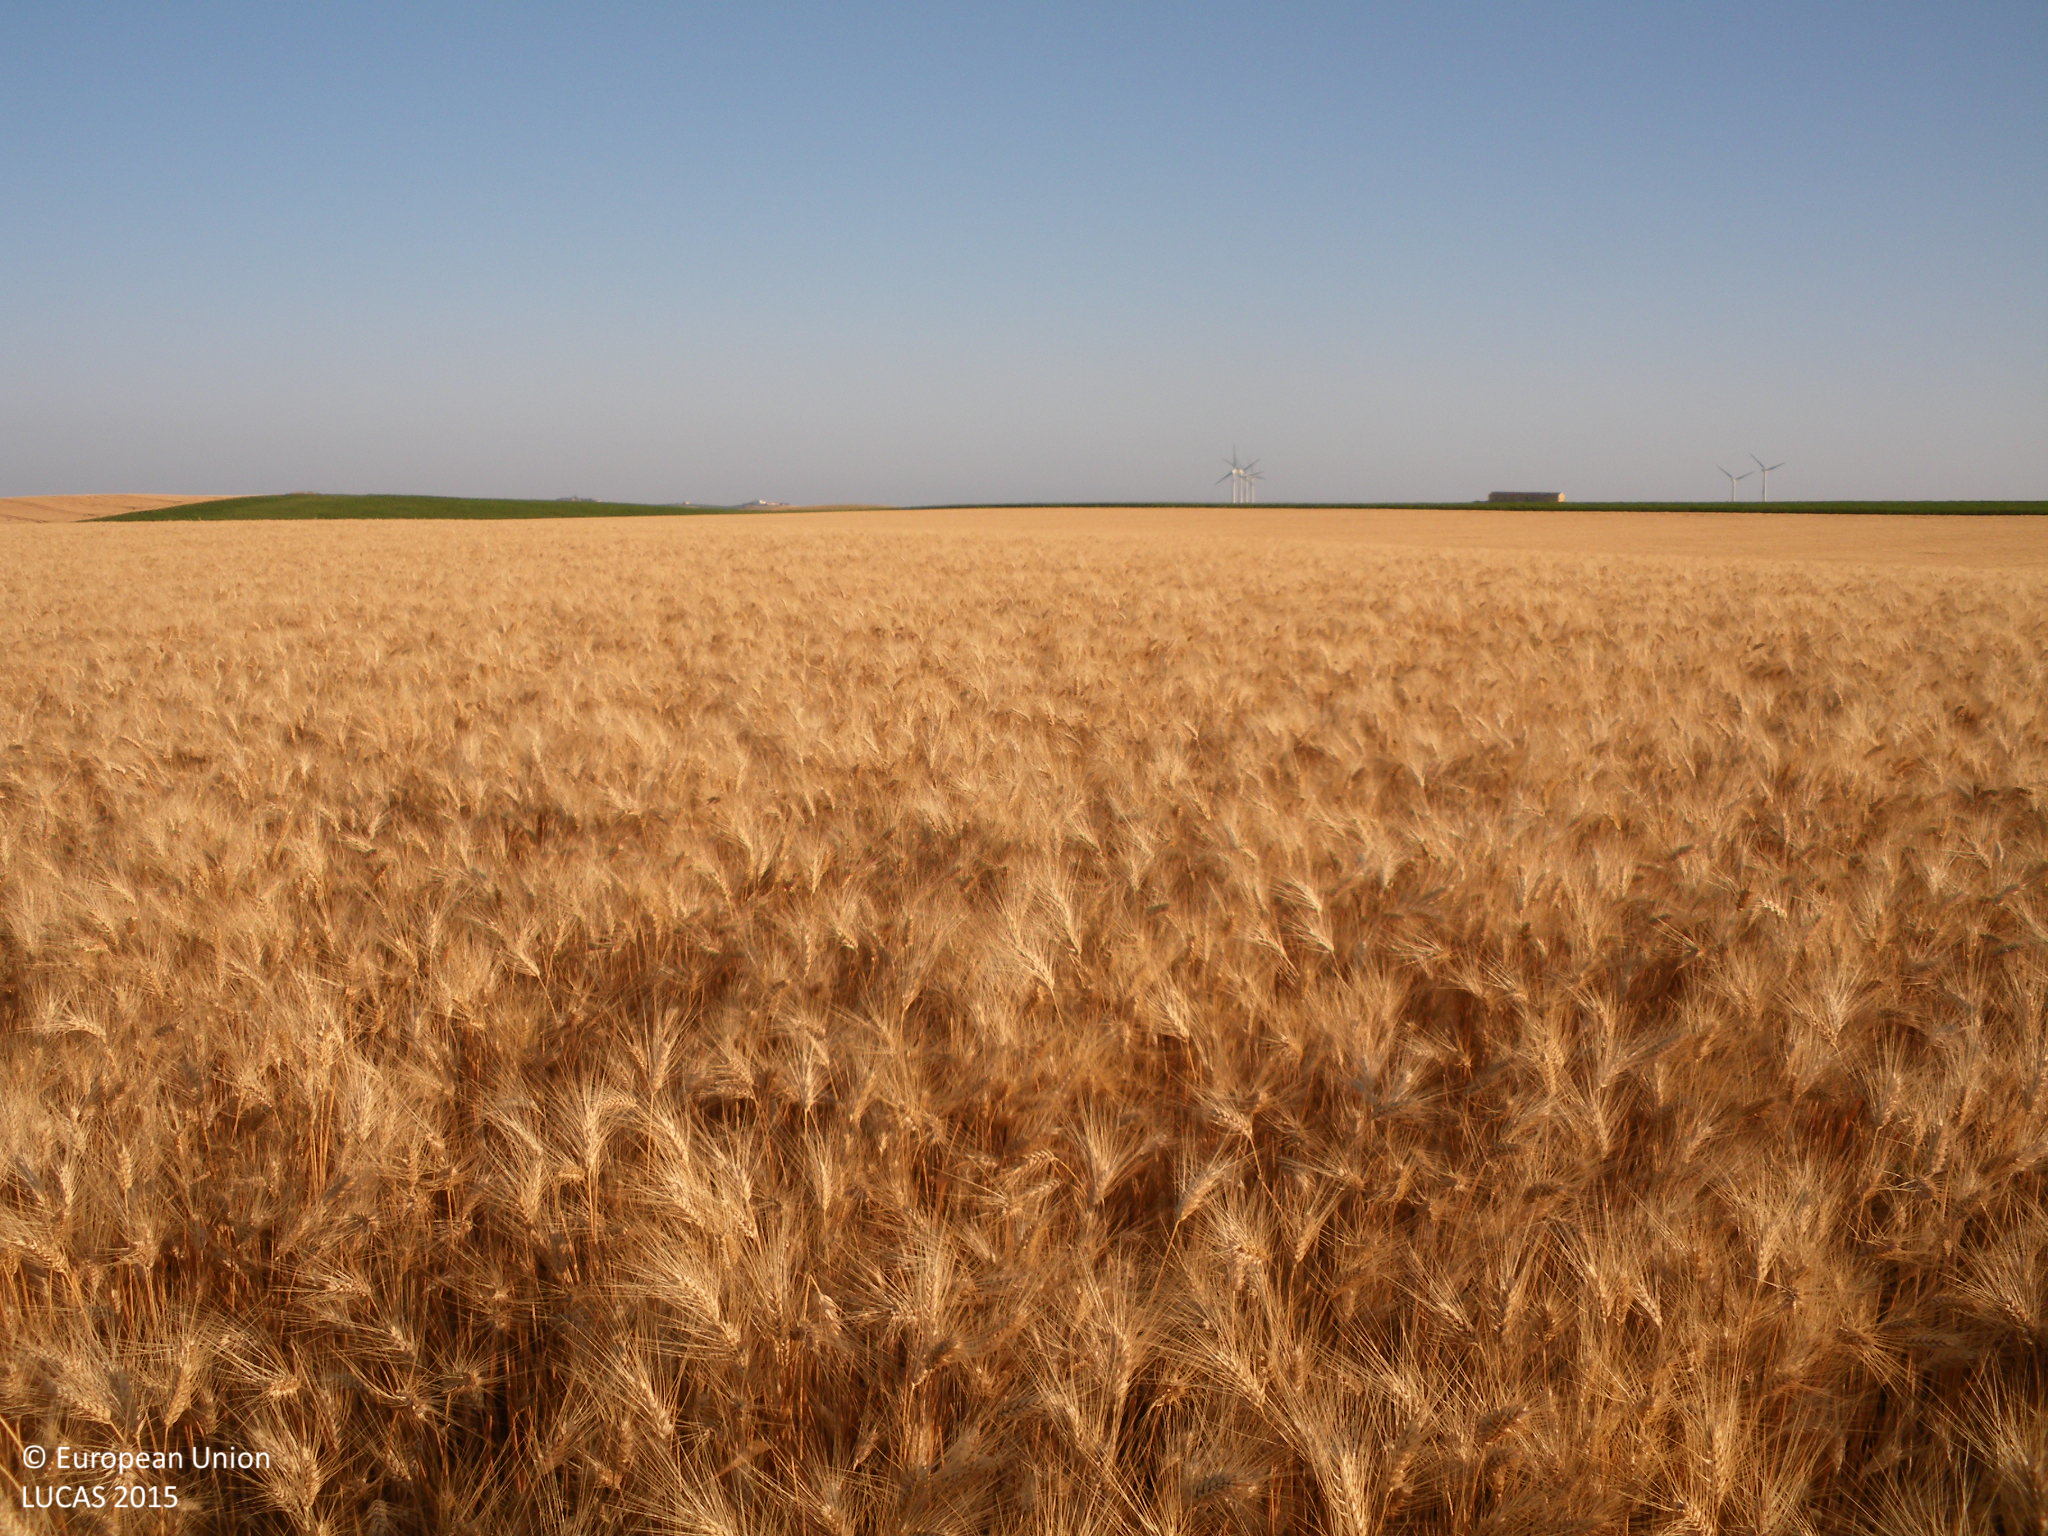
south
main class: Cropland
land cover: Durum wheat
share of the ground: > 75 %
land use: Agriculture (excluding fallow land and kitchen gardens)
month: May
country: ES
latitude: 36.7606
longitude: -6.2700
